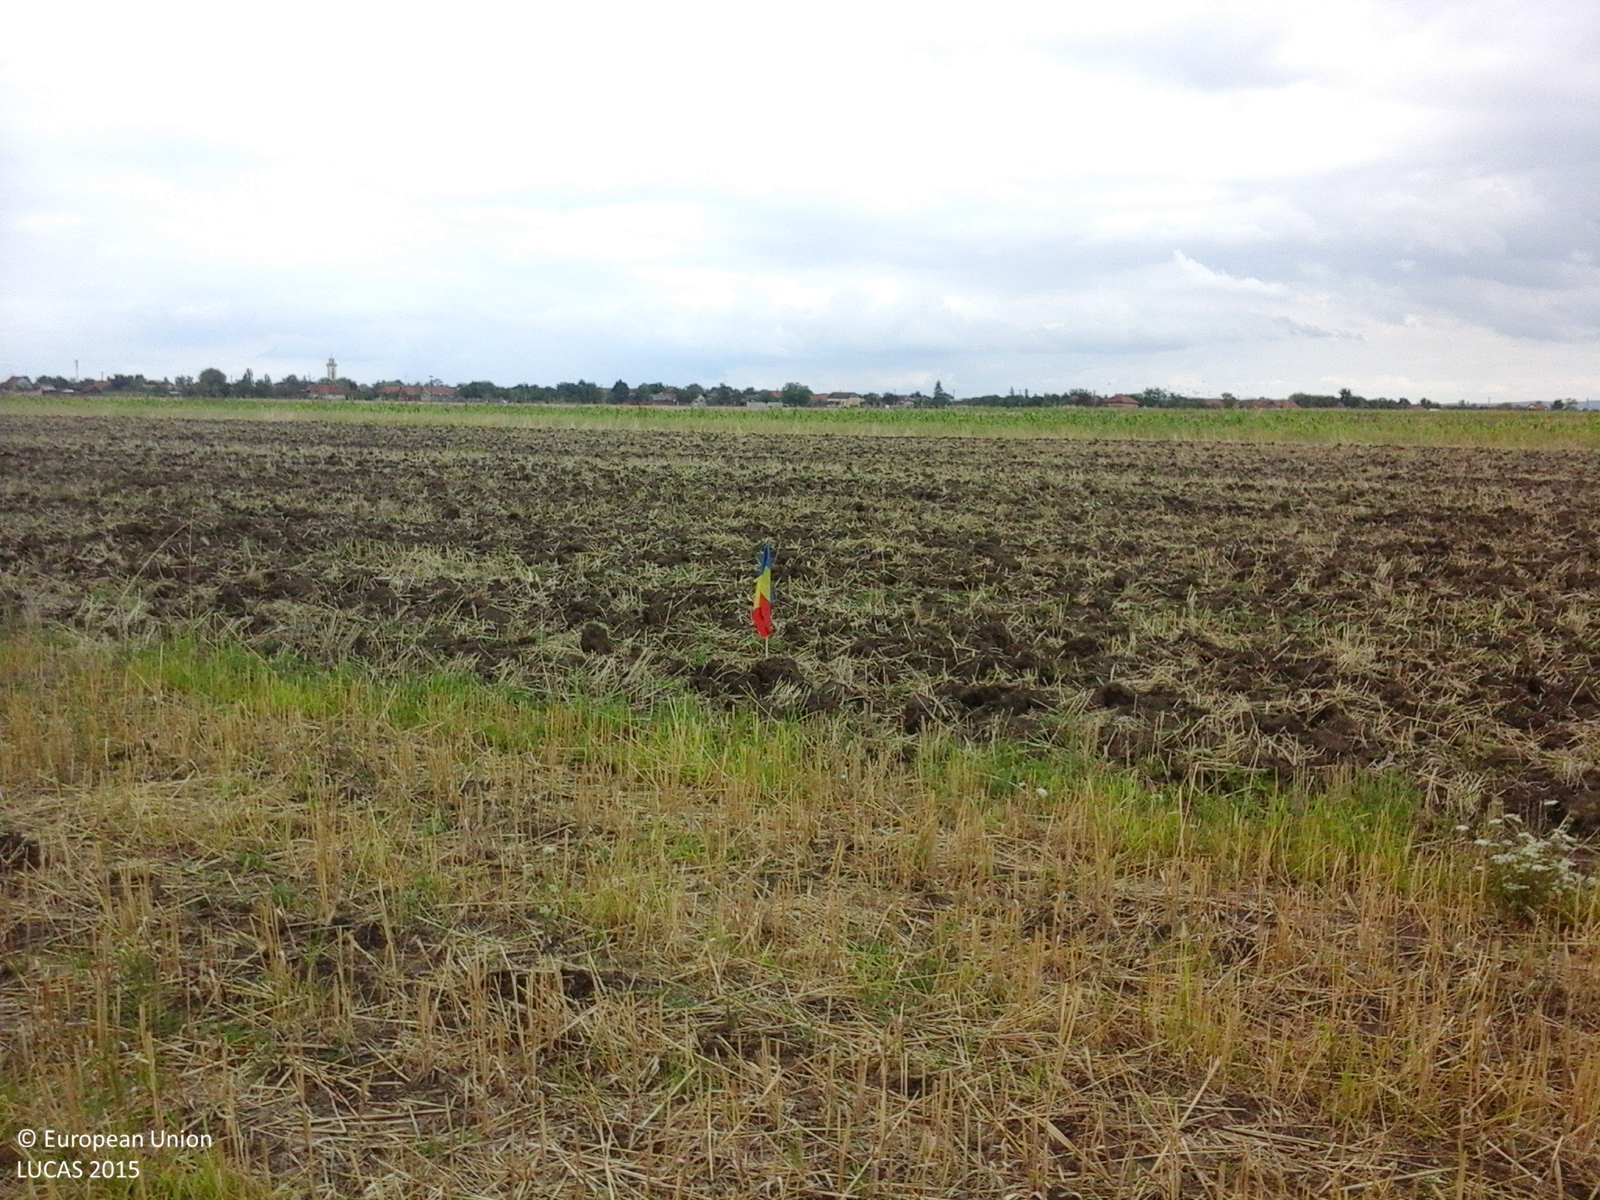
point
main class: Cropland
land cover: Common wheat
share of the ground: 10 - 25 %
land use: Agriculture (excluding fallow land and kitchen gardens)
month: August
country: RO
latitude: 45.5117
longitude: 21.4885
